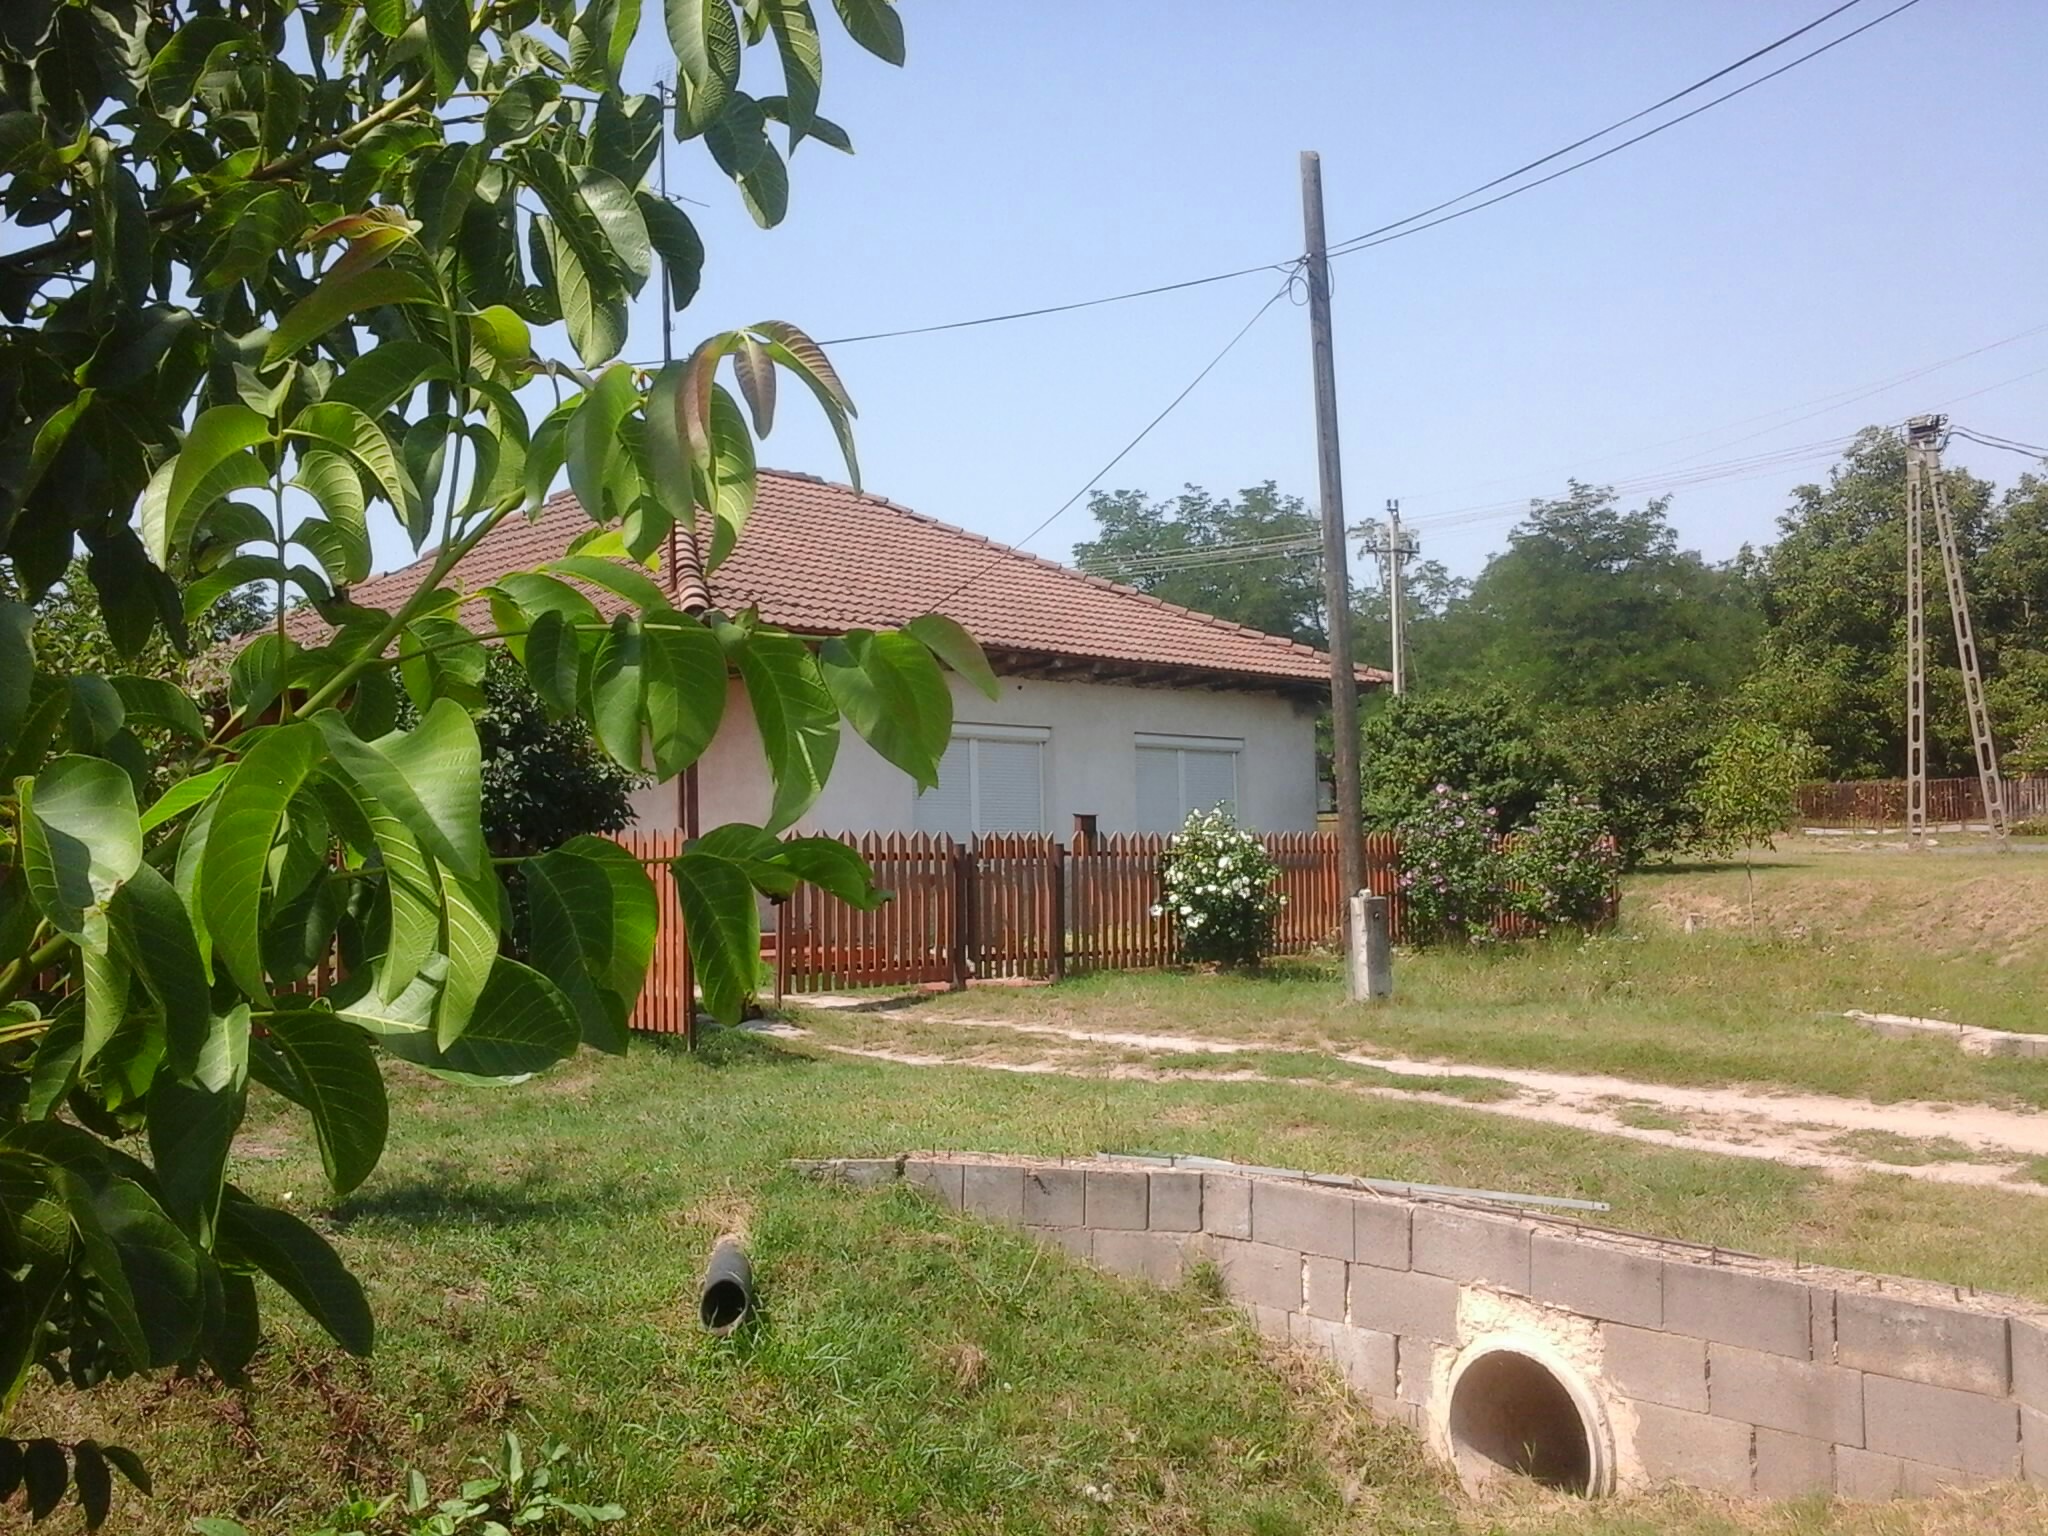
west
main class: Grassland
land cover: Grassland without tree/shrub cover
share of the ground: > 75 %
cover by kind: herbaceous plants 100 %
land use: Residential
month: August
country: HU
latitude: 47.4616
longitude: 18.0098
